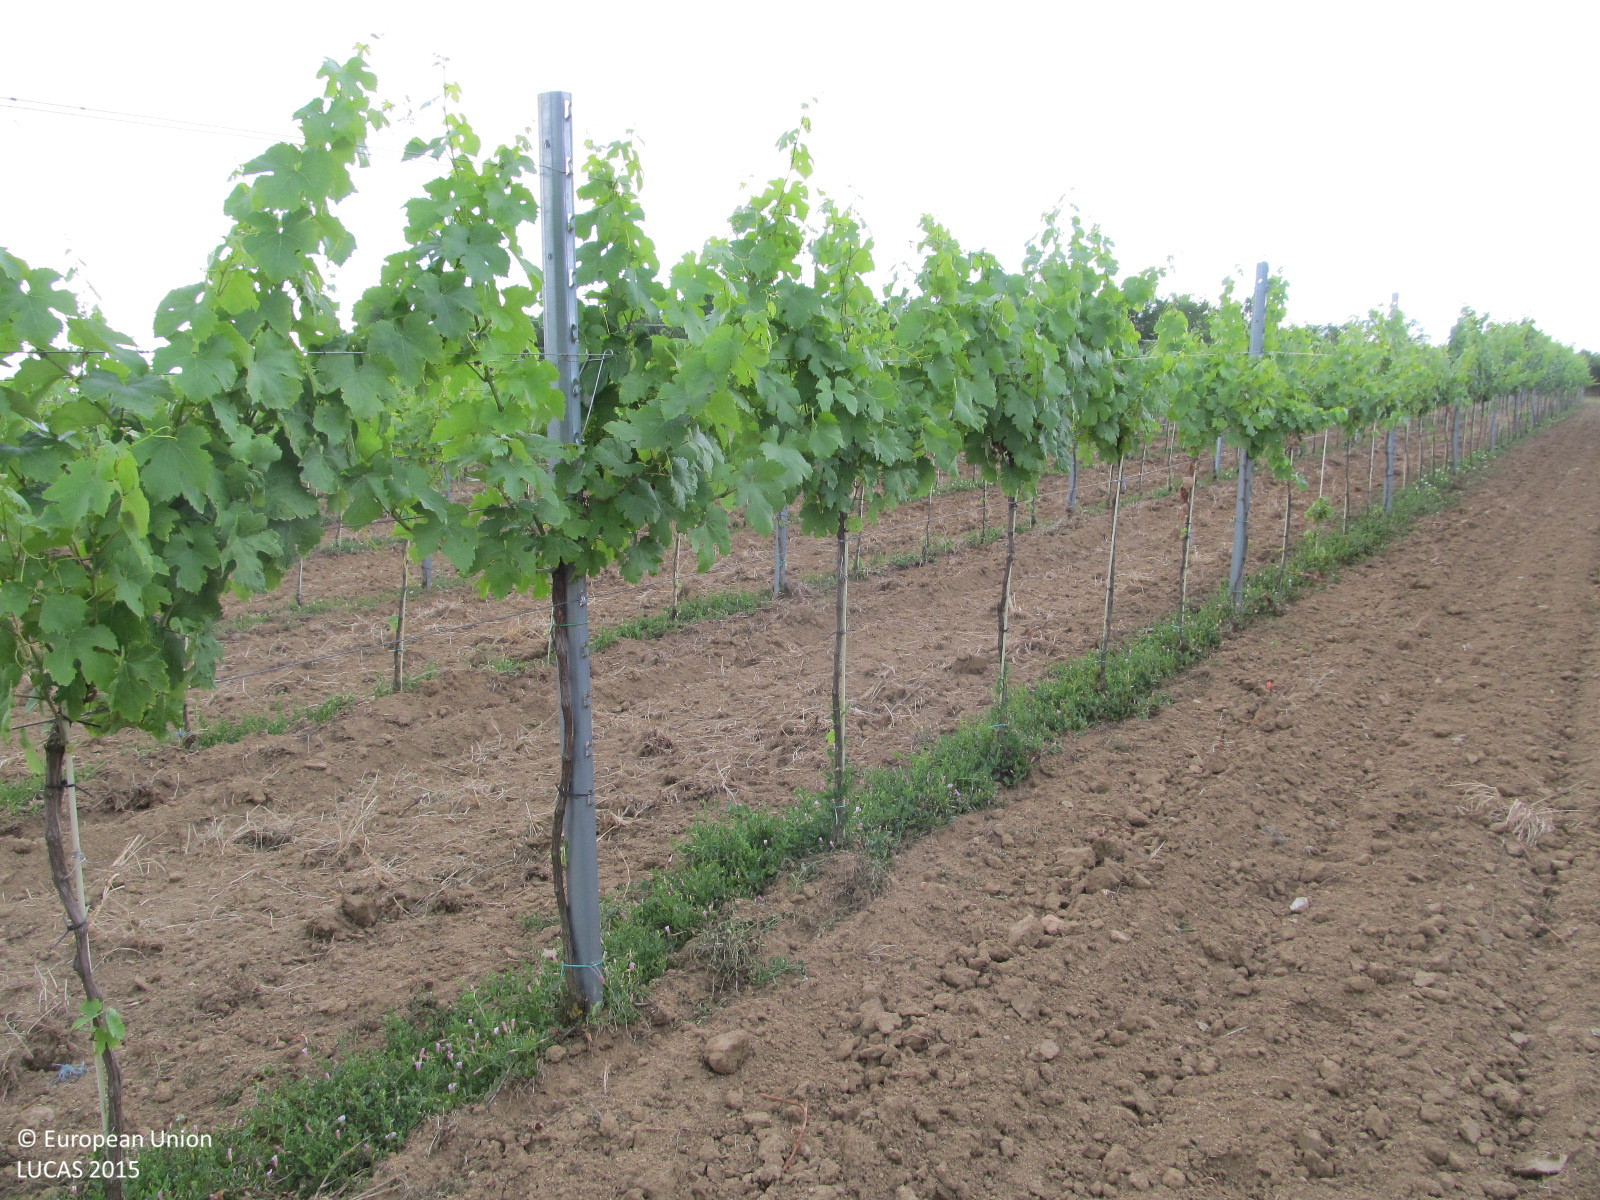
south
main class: Cropland
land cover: Vineyards
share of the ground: 25 - 50 %
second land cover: Other bare soil
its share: > 75 %
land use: Agriculture (excluding fallow land and kitchen gardens)
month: June
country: AT
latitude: 48.7500
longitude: 15.9207
